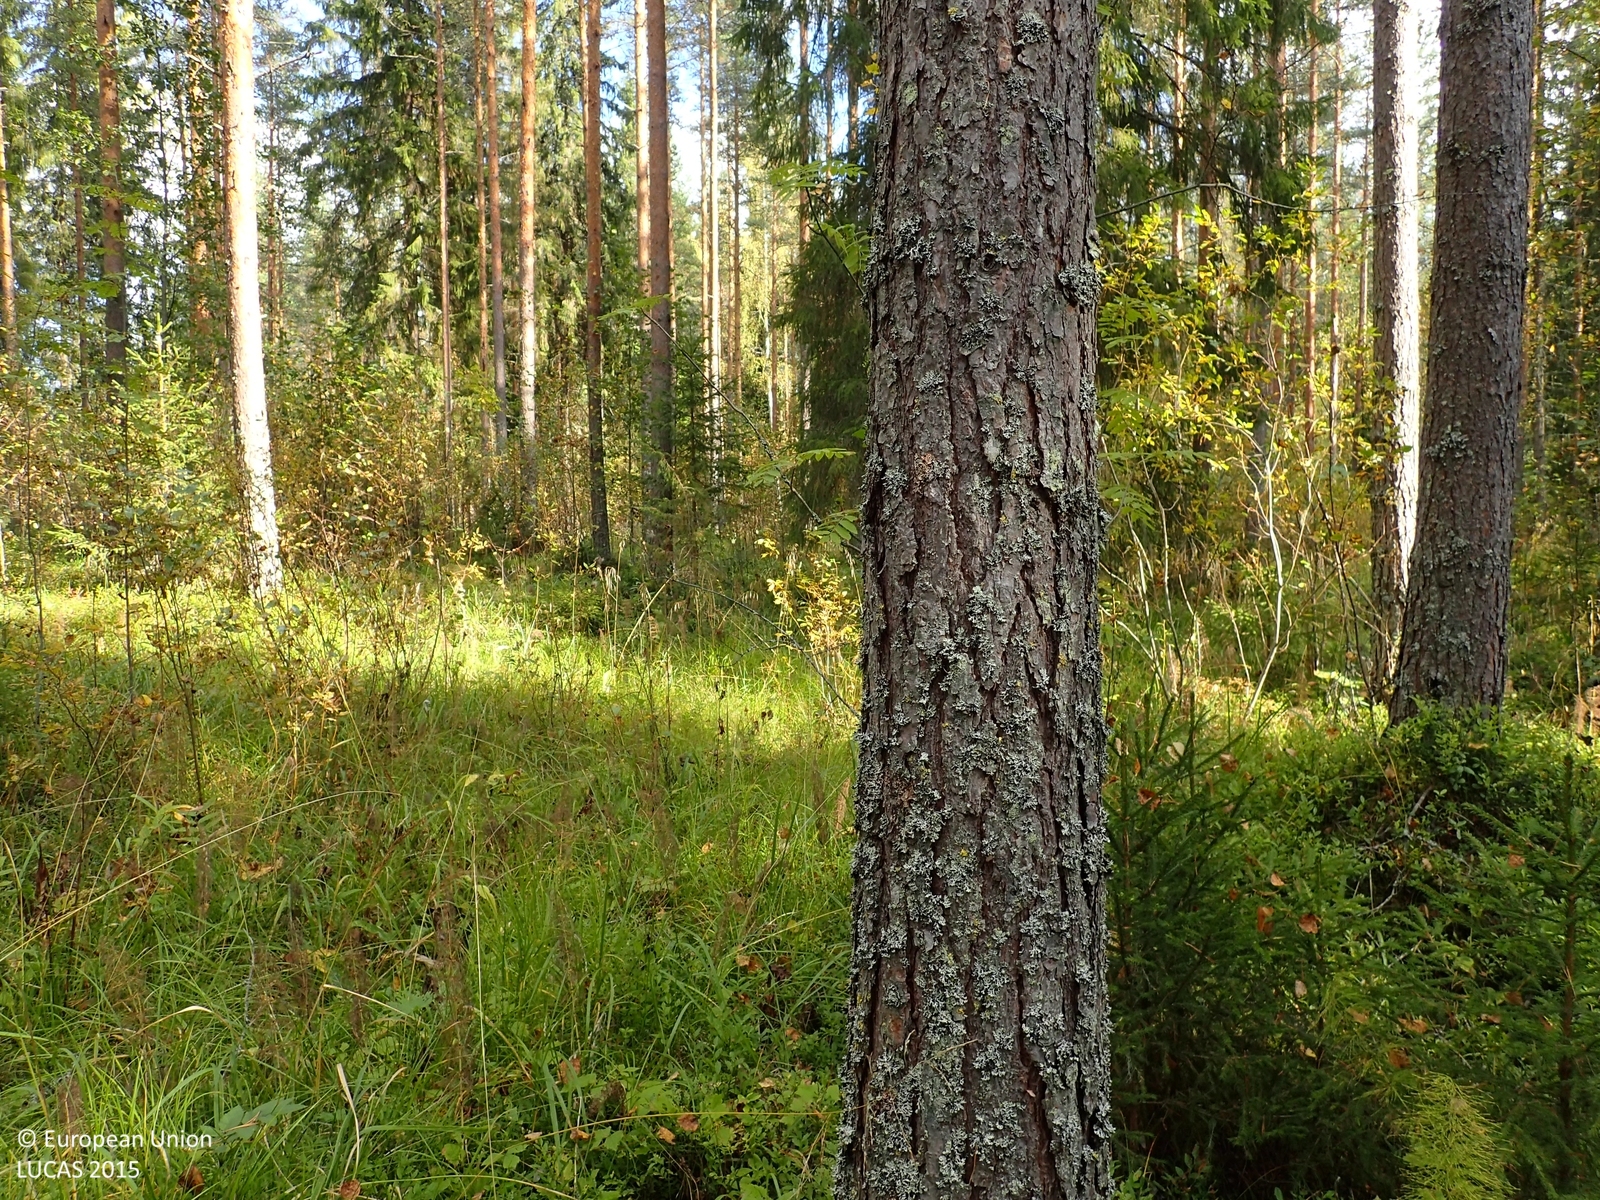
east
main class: Woodland
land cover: Pine dominated mixed woodland
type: boreal forest
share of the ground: > 75 %
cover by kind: coniferous forest trees 55 %, broadleaved forest trees 20 %, herbaceous plants 15 %, shrubs 10 %
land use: Forestry
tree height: > 5 m
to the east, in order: Pine dominated mixed woodland; Tracks; Electric lines; Pine dominated mixed woodland; Ditches and canals; Other mixed woodland; Pine dominated mixed woodland; Broadleaved woodland; Electric lines; Broadleaved woodland; Ditches and canals; Paved roads, cycling and walking lanes; Ditches and canals
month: September
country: FI
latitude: 63.0362
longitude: 25.3439
